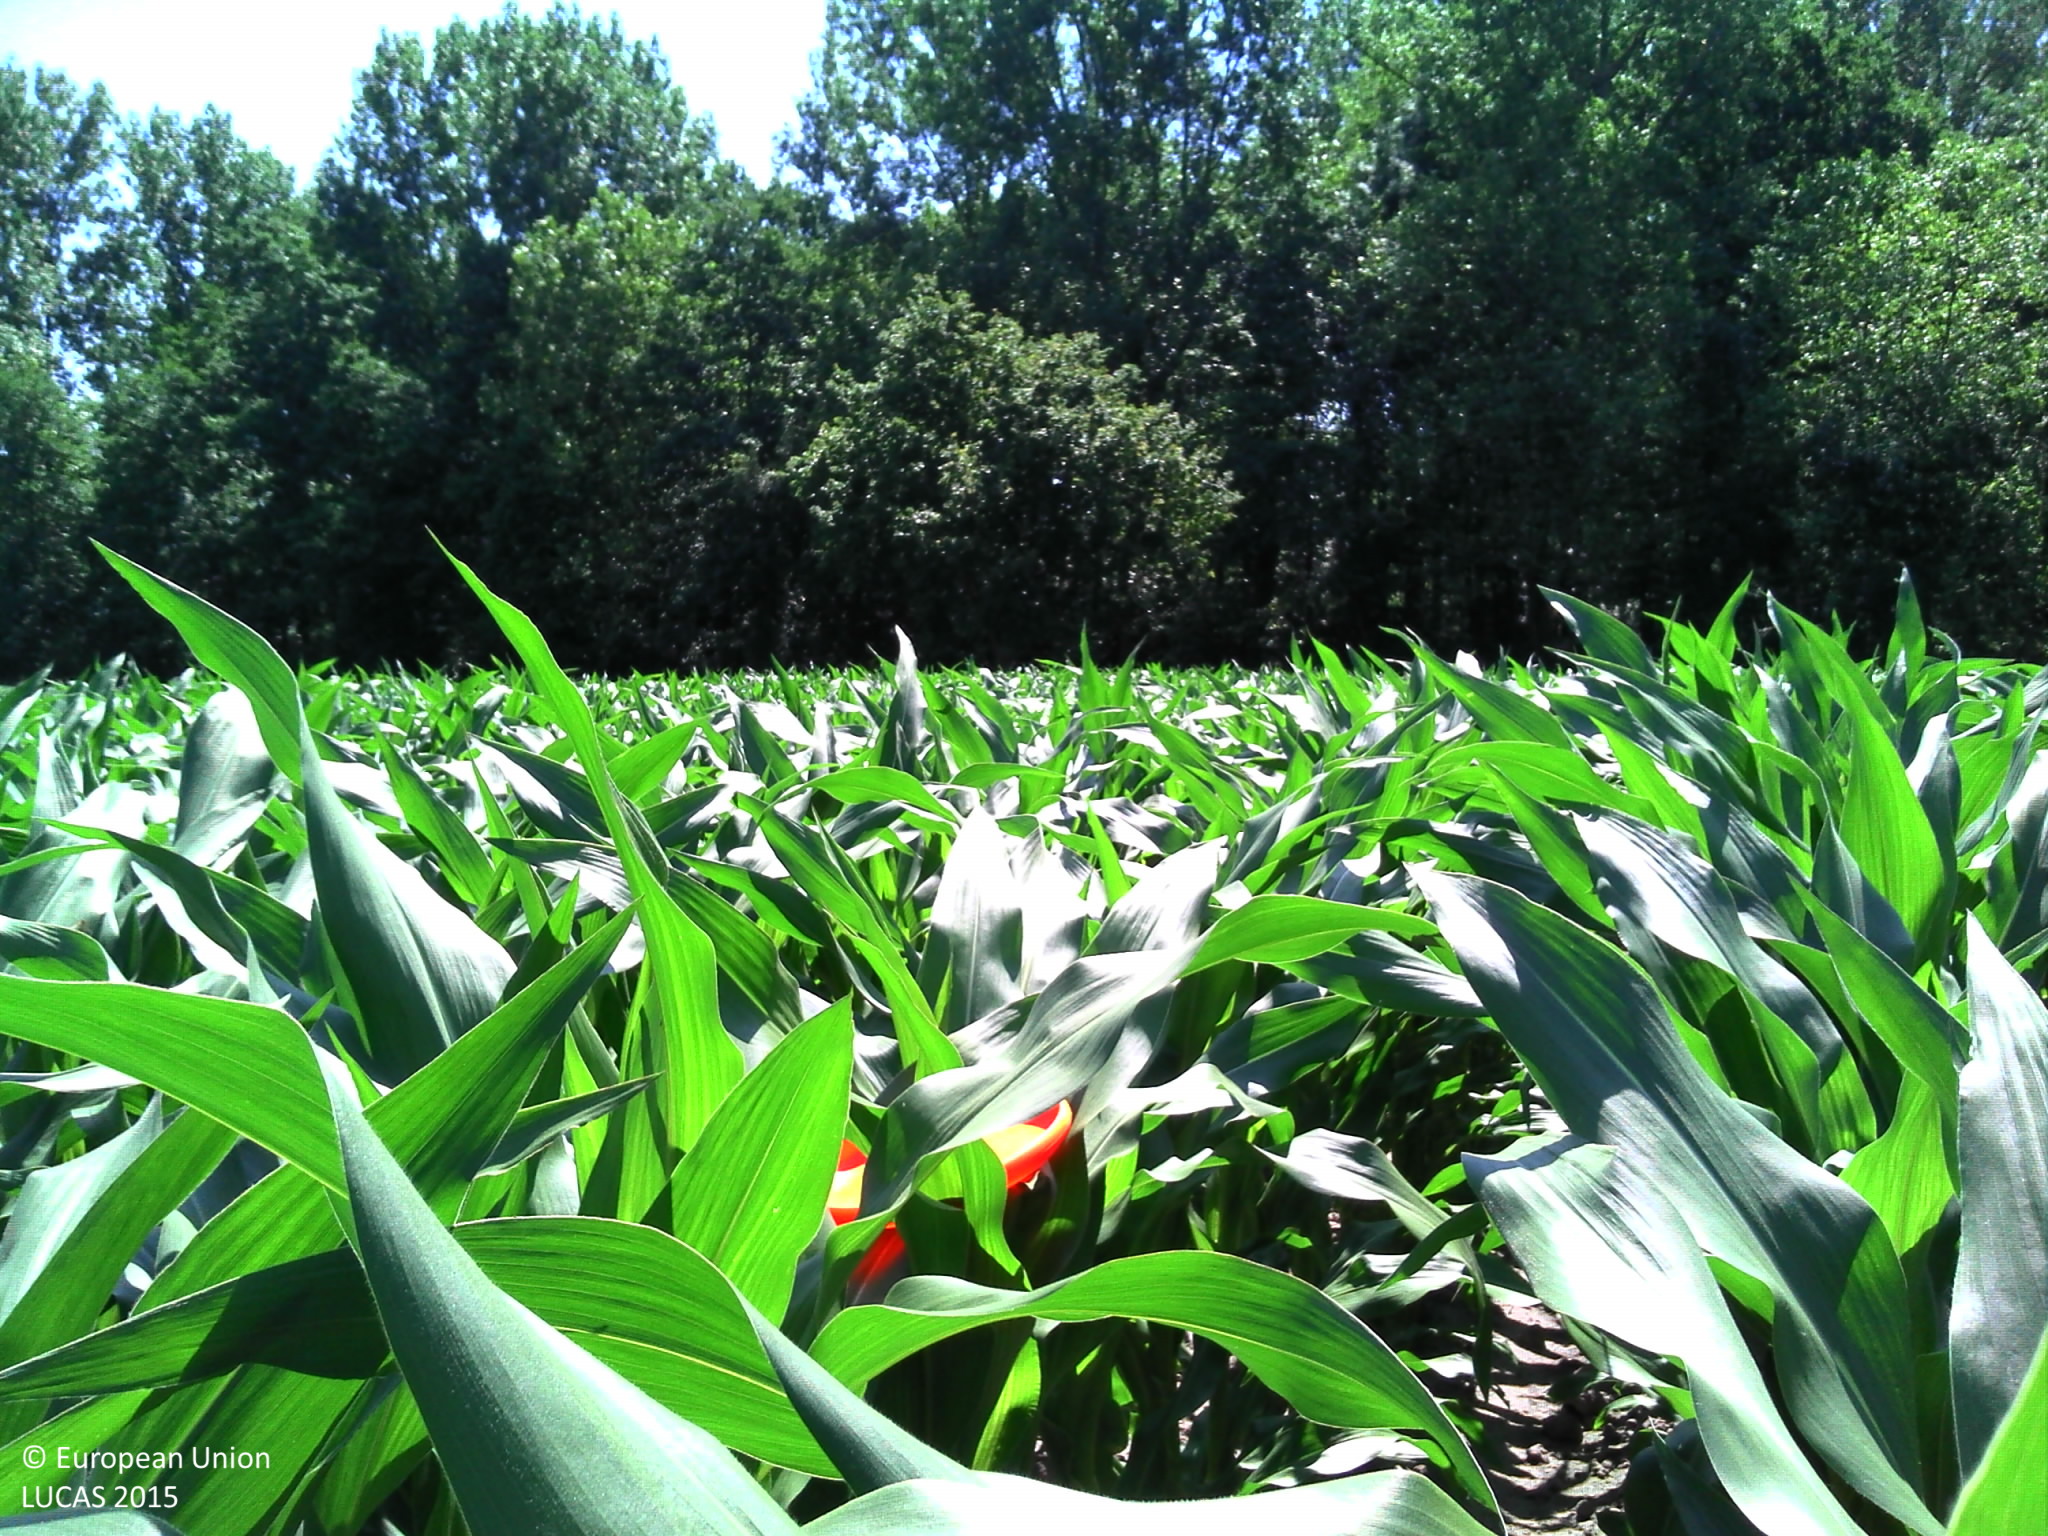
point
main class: Cropland
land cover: Maize
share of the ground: > 75 %
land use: Agriculture (excluding fallow land and kitchen gardens)
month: June
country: BE
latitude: 51.1620
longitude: 3.6581
